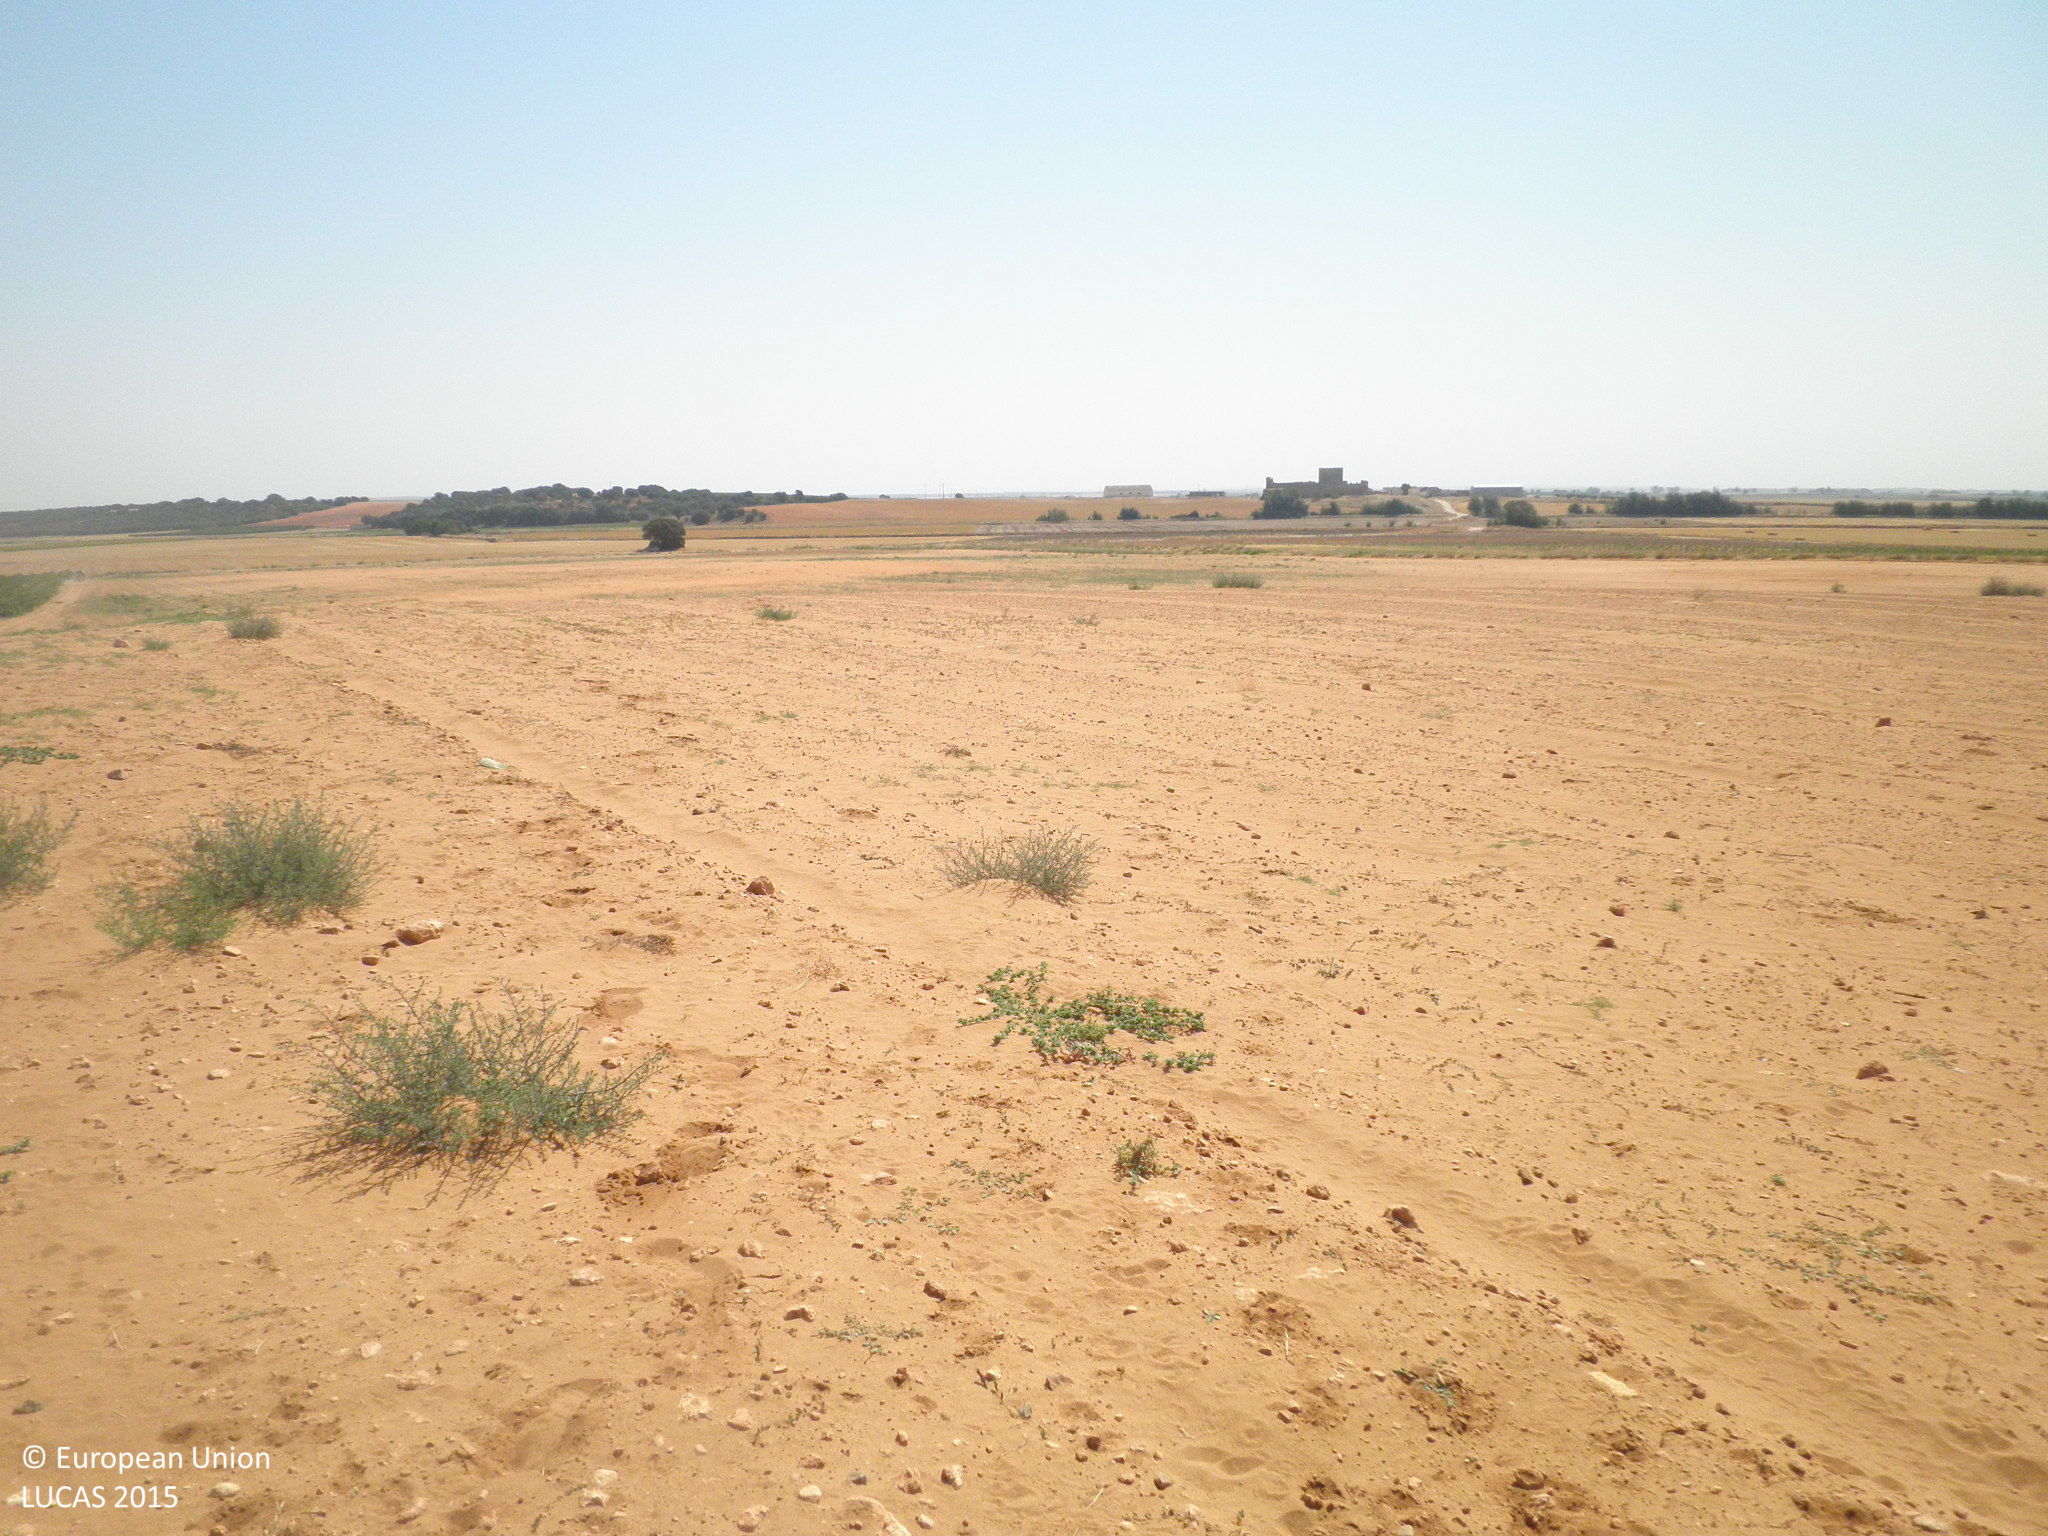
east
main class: Grassland
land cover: Spontaneously vegetated surfaces
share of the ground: 10 - 25 %
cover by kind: unconsolidated bare surface 90 %, herbaceous plants 10 %
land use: Fallow land
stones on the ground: 10 - 25 %
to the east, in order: Spontaneously vegetated surfaces; Other bare soil; Spontaneously vegetated surfaces
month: July
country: ES
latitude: 39.4339
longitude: -2.5944
